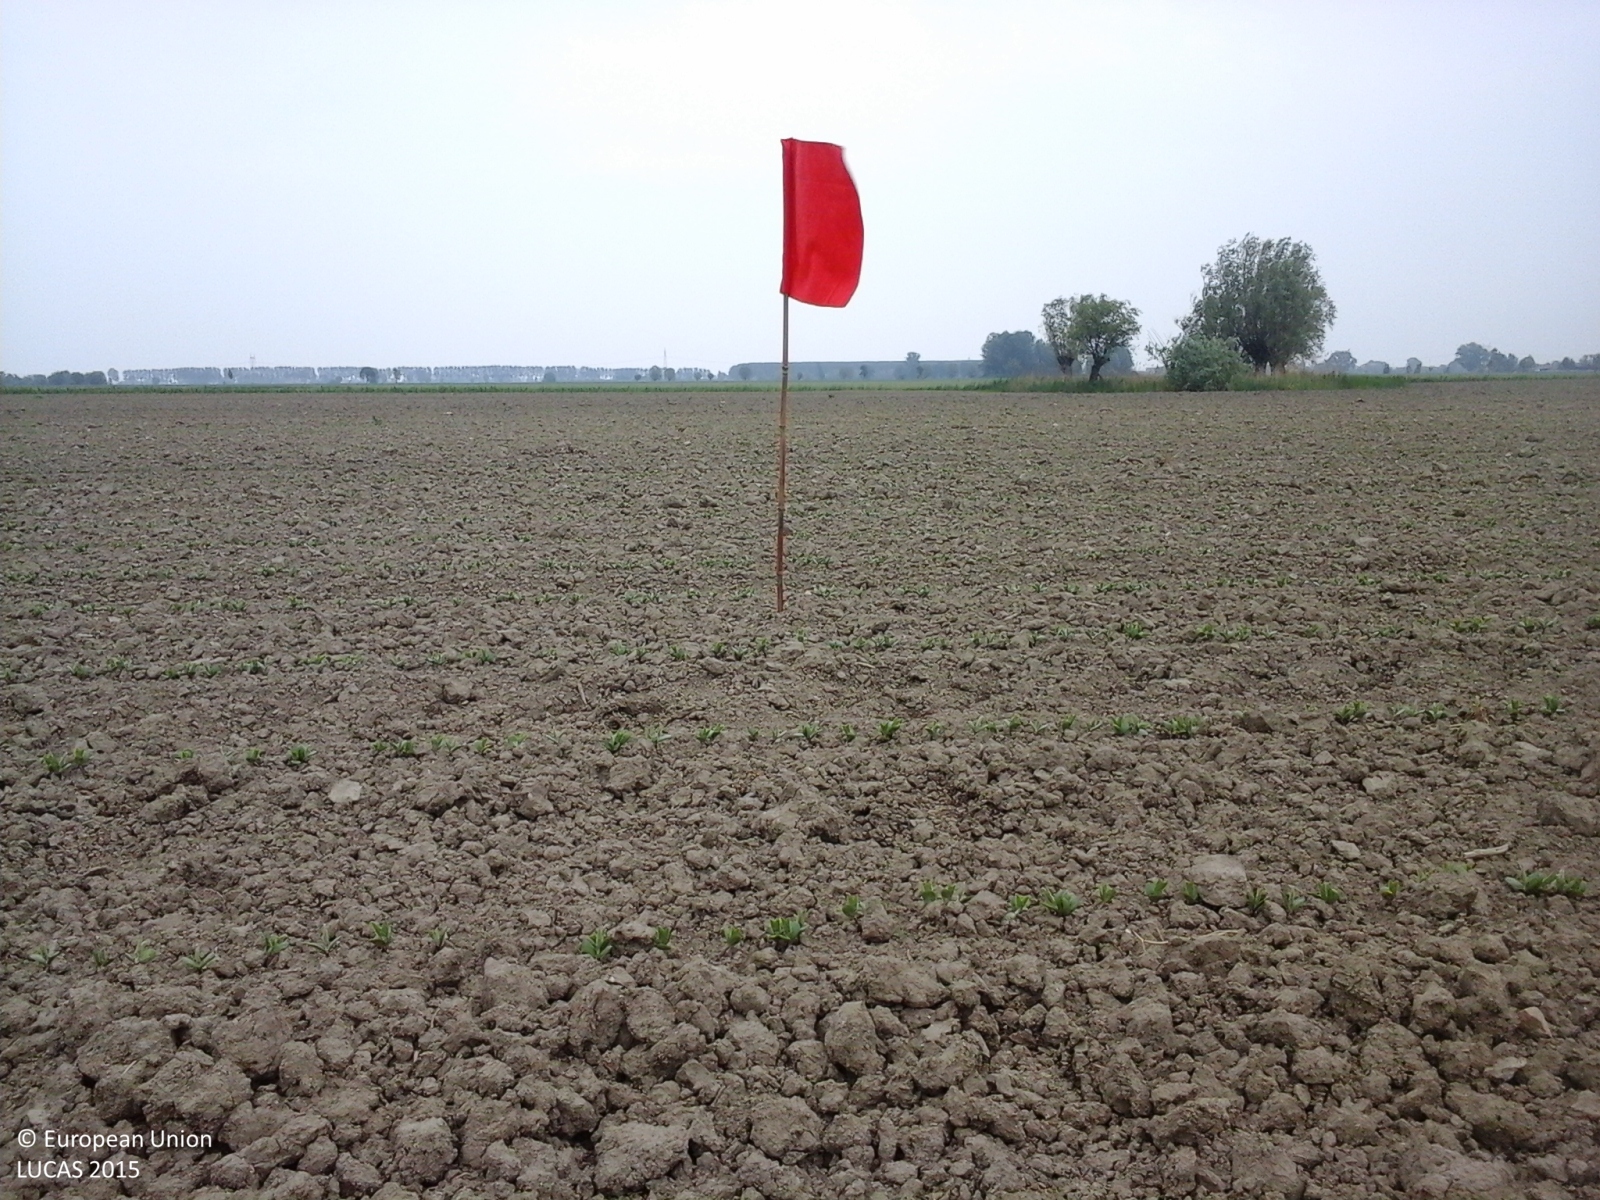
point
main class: Cropland
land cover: Soya
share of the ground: > 75 %
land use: Agriculture (excluding fallow land and kitchen gardens)
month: May
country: IT
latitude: 44.9701
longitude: 11.5566
